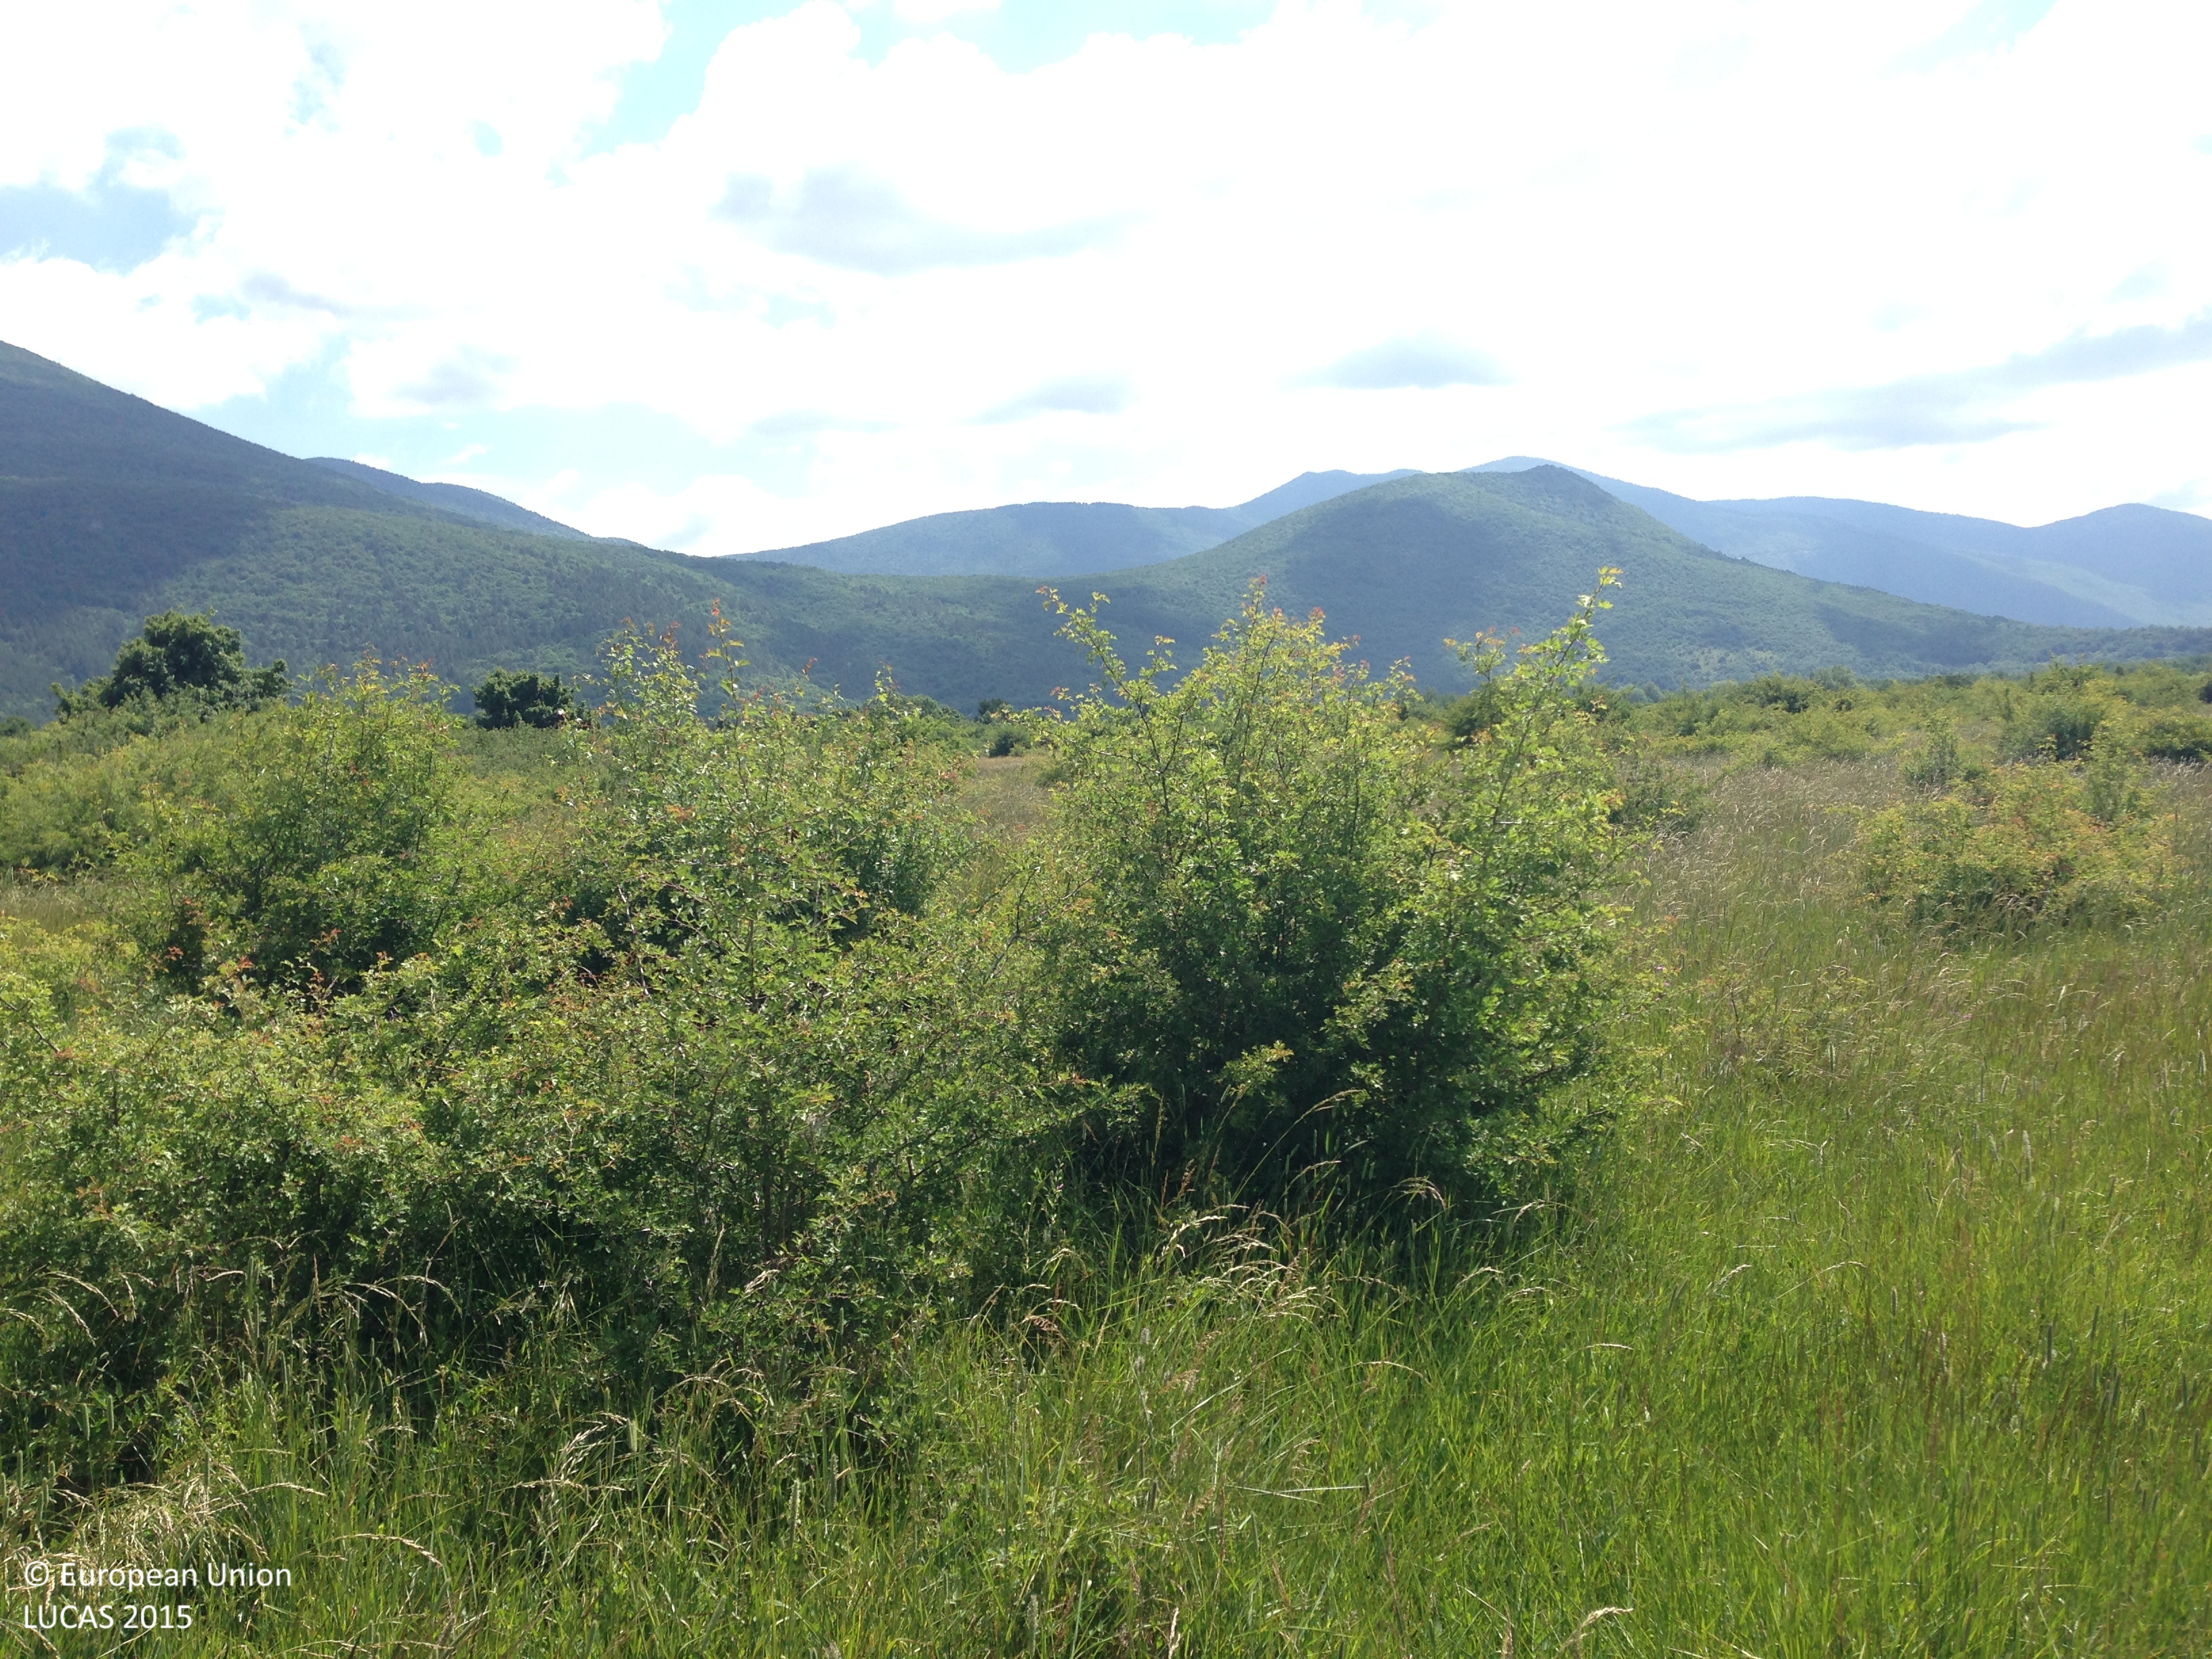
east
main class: Shrubland
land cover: Shrubland with sparse tree cover
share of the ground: 10 - 25 %
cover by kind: herbaceous plants 65 %, shrubs 20 %, broadleaved forest trees 5 %, consolidated bare surface 5 %, unconsolidated bare surface 5 %
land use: Semi-natural and natural areas not in use
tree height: < 5 m
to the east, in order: Shrubland with sparse tree cover
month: June
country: HR
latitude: 44.7339
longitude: 15.7398
